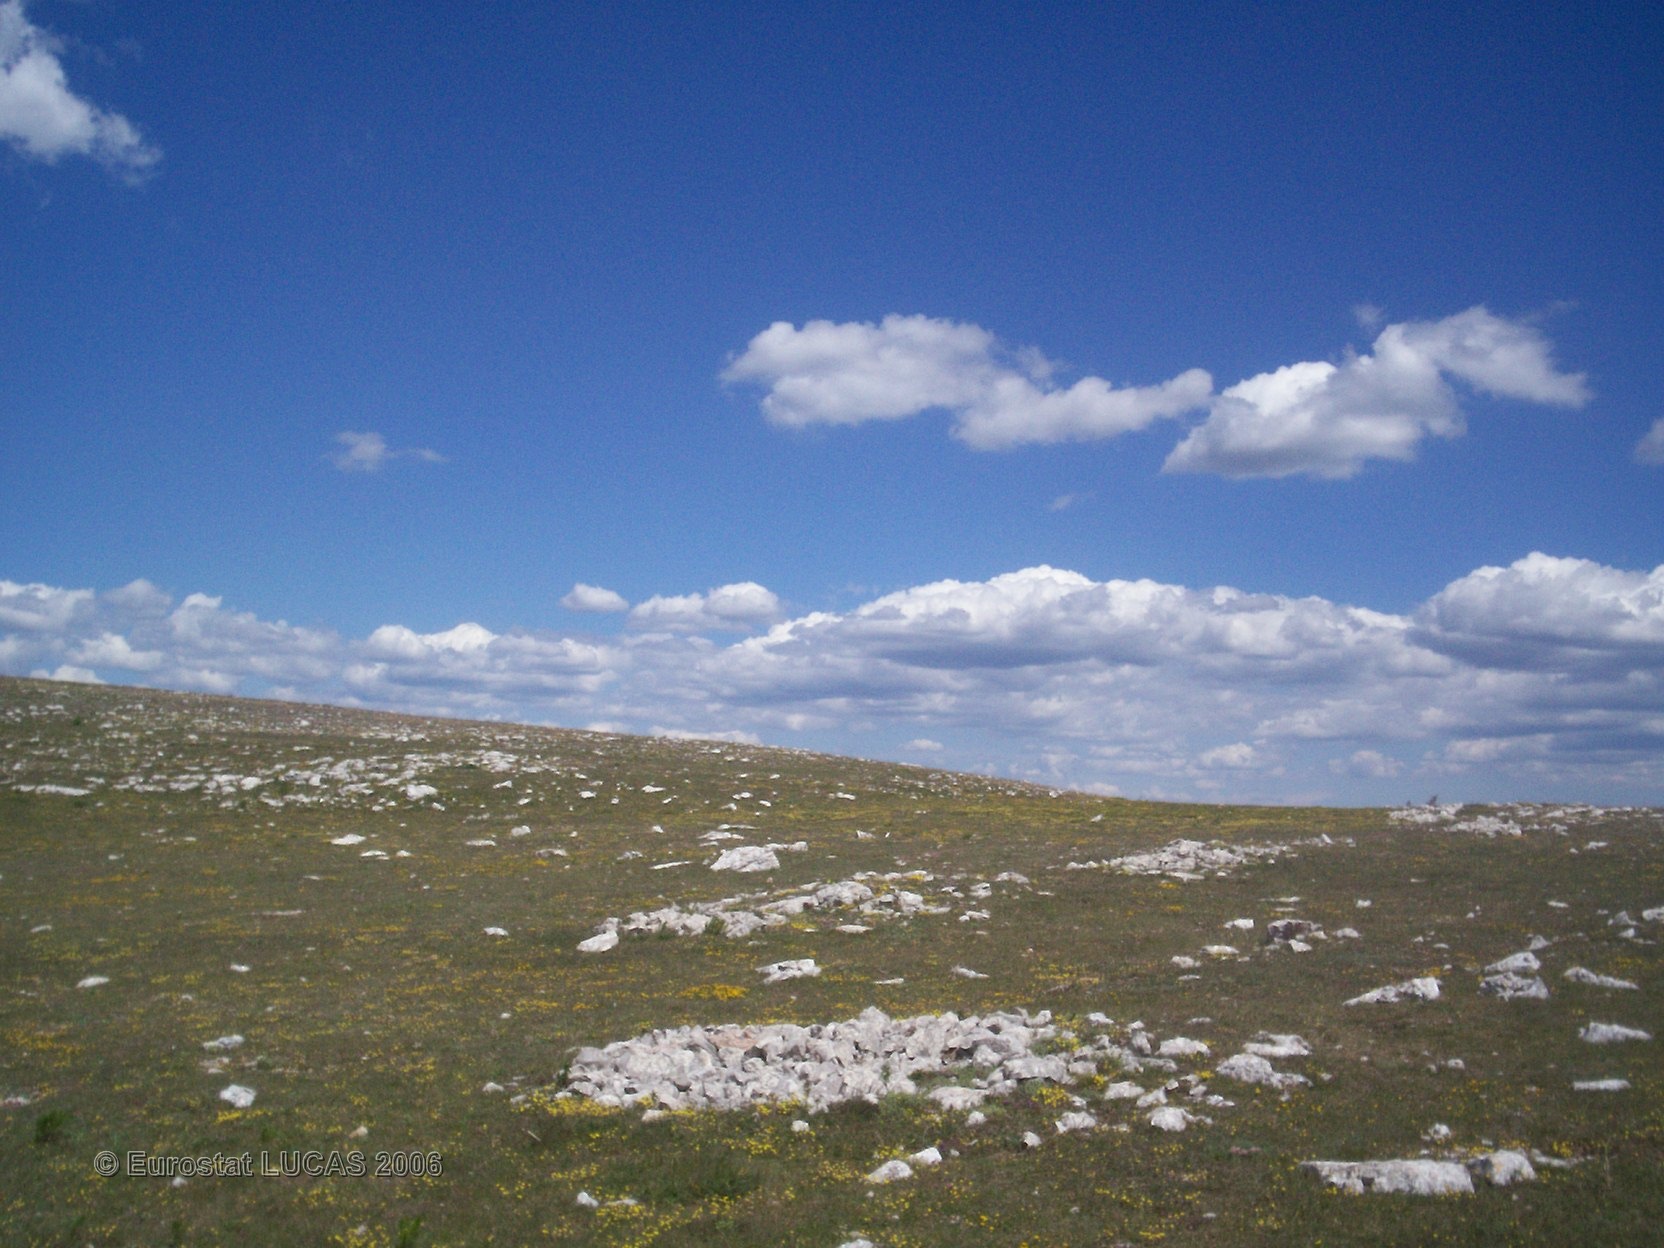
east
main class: Grassland
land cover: Grassland without tree/shrub cover
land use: Agriculture (excluding fallow land and kitchen gardens)
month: June
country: FR
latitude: 44.2165
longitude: 3.4601
